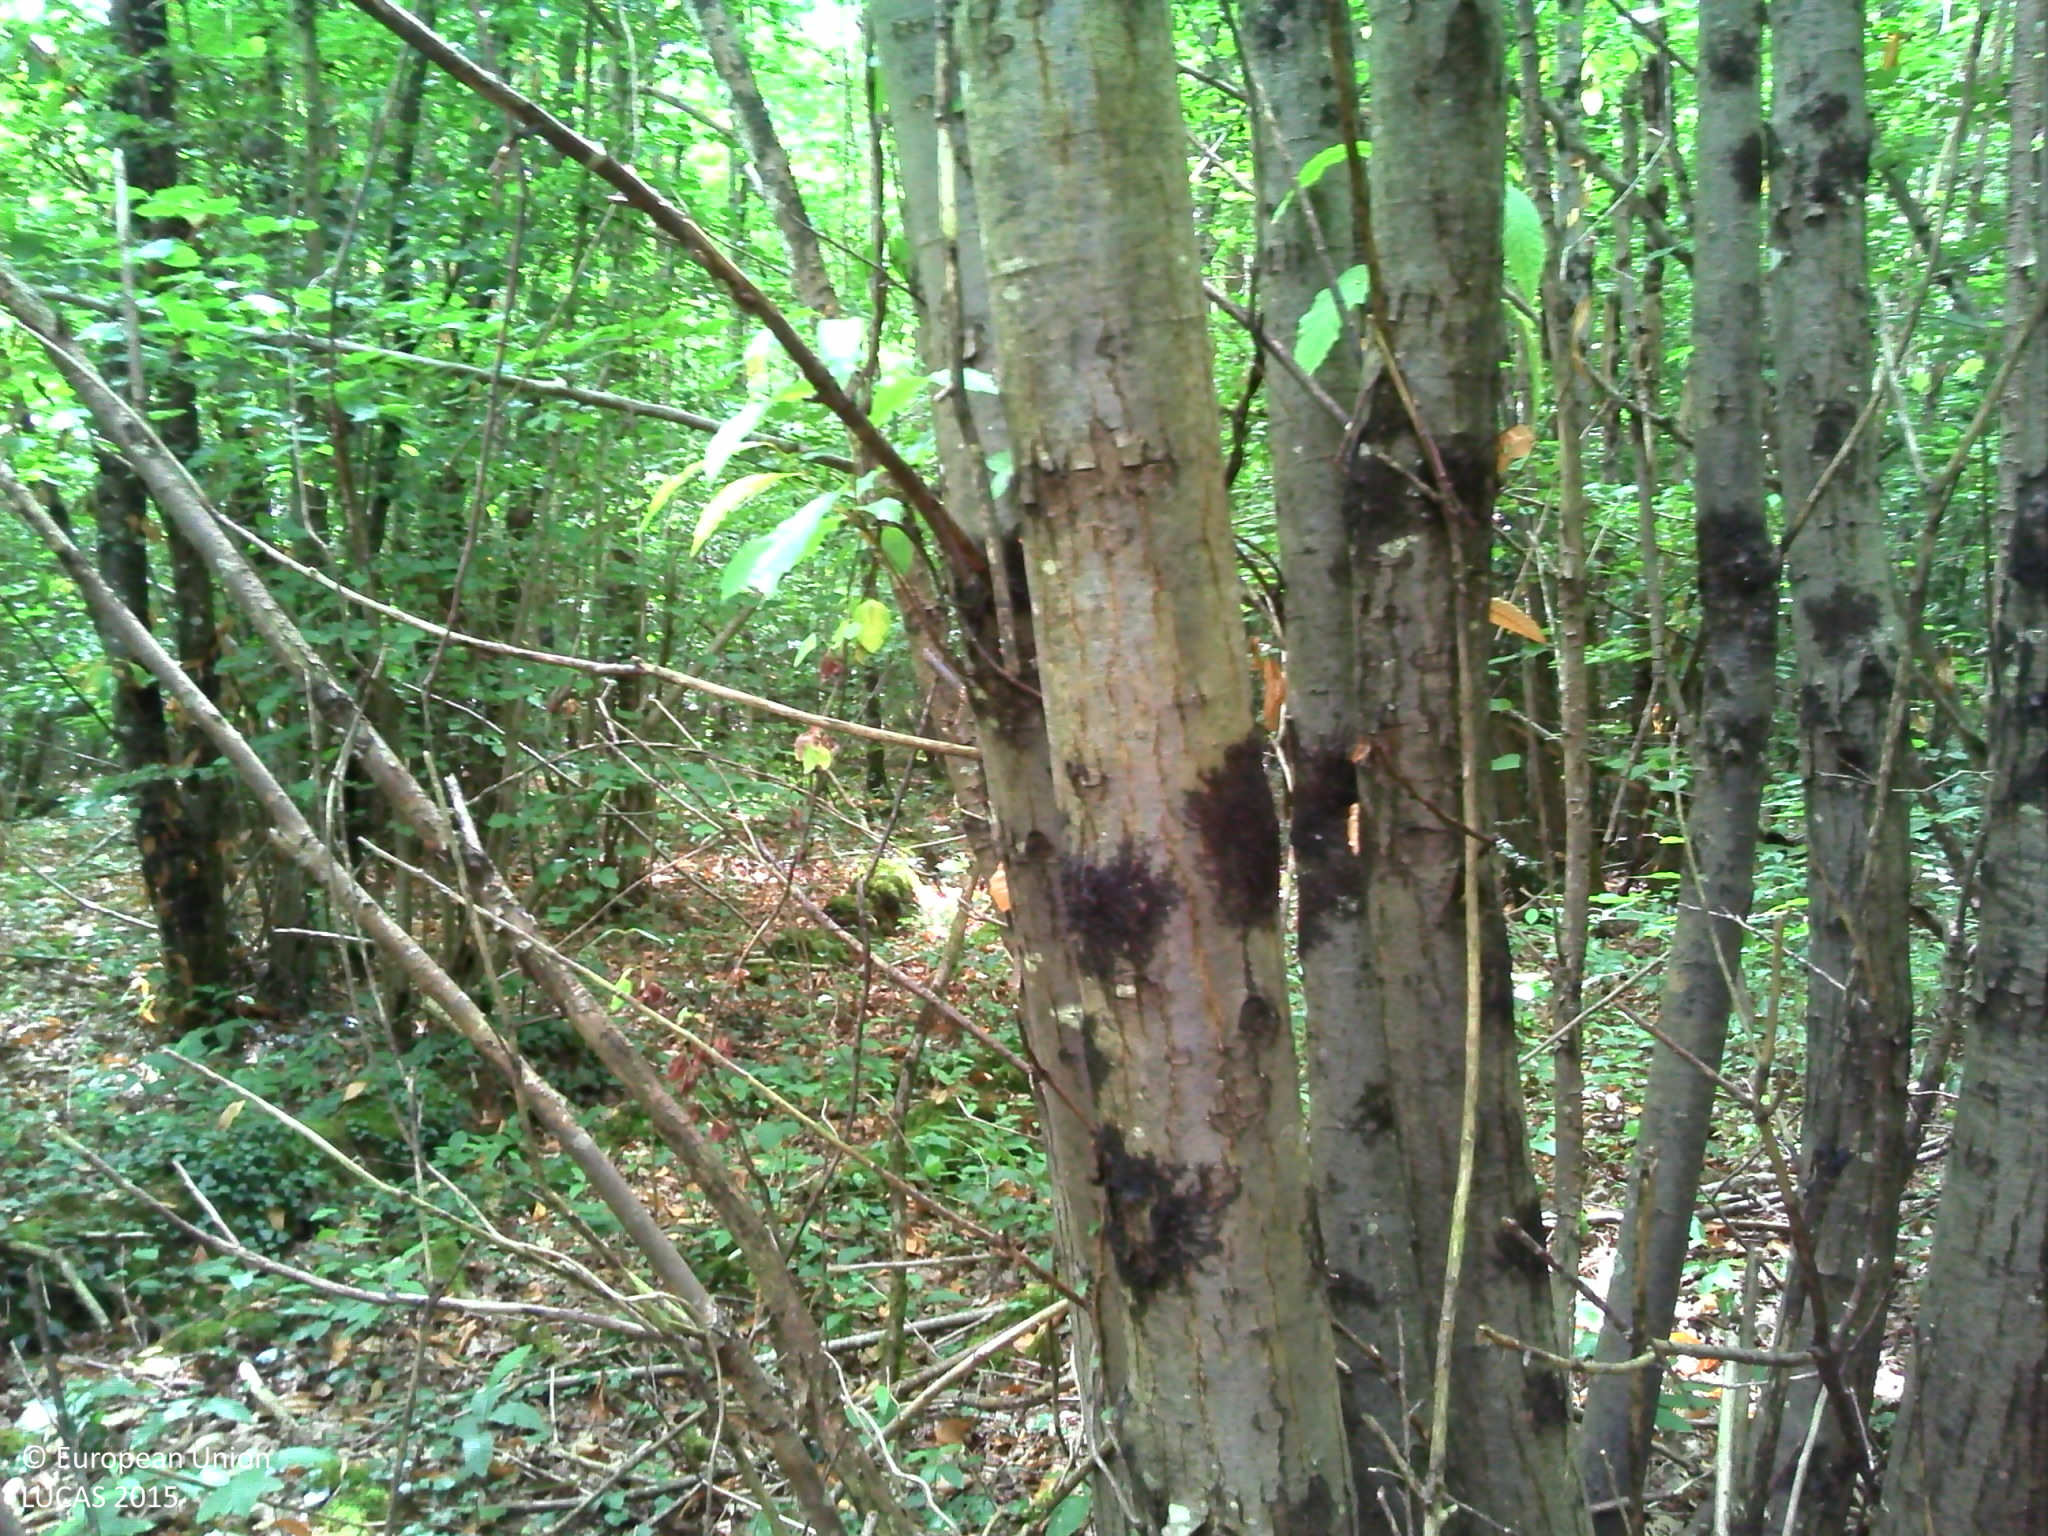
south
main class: Woodland
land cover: Broadleaved woodland
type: acidophilous oak and oak-birch forest
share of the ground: > 75 %
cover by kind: broadleaved forest trees 85 %, shrubs 10 %, herbaceous plants 5 %
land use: Forestry
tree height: > 5 m
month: July
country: FR
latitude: 46.4494
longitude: 0.2562
